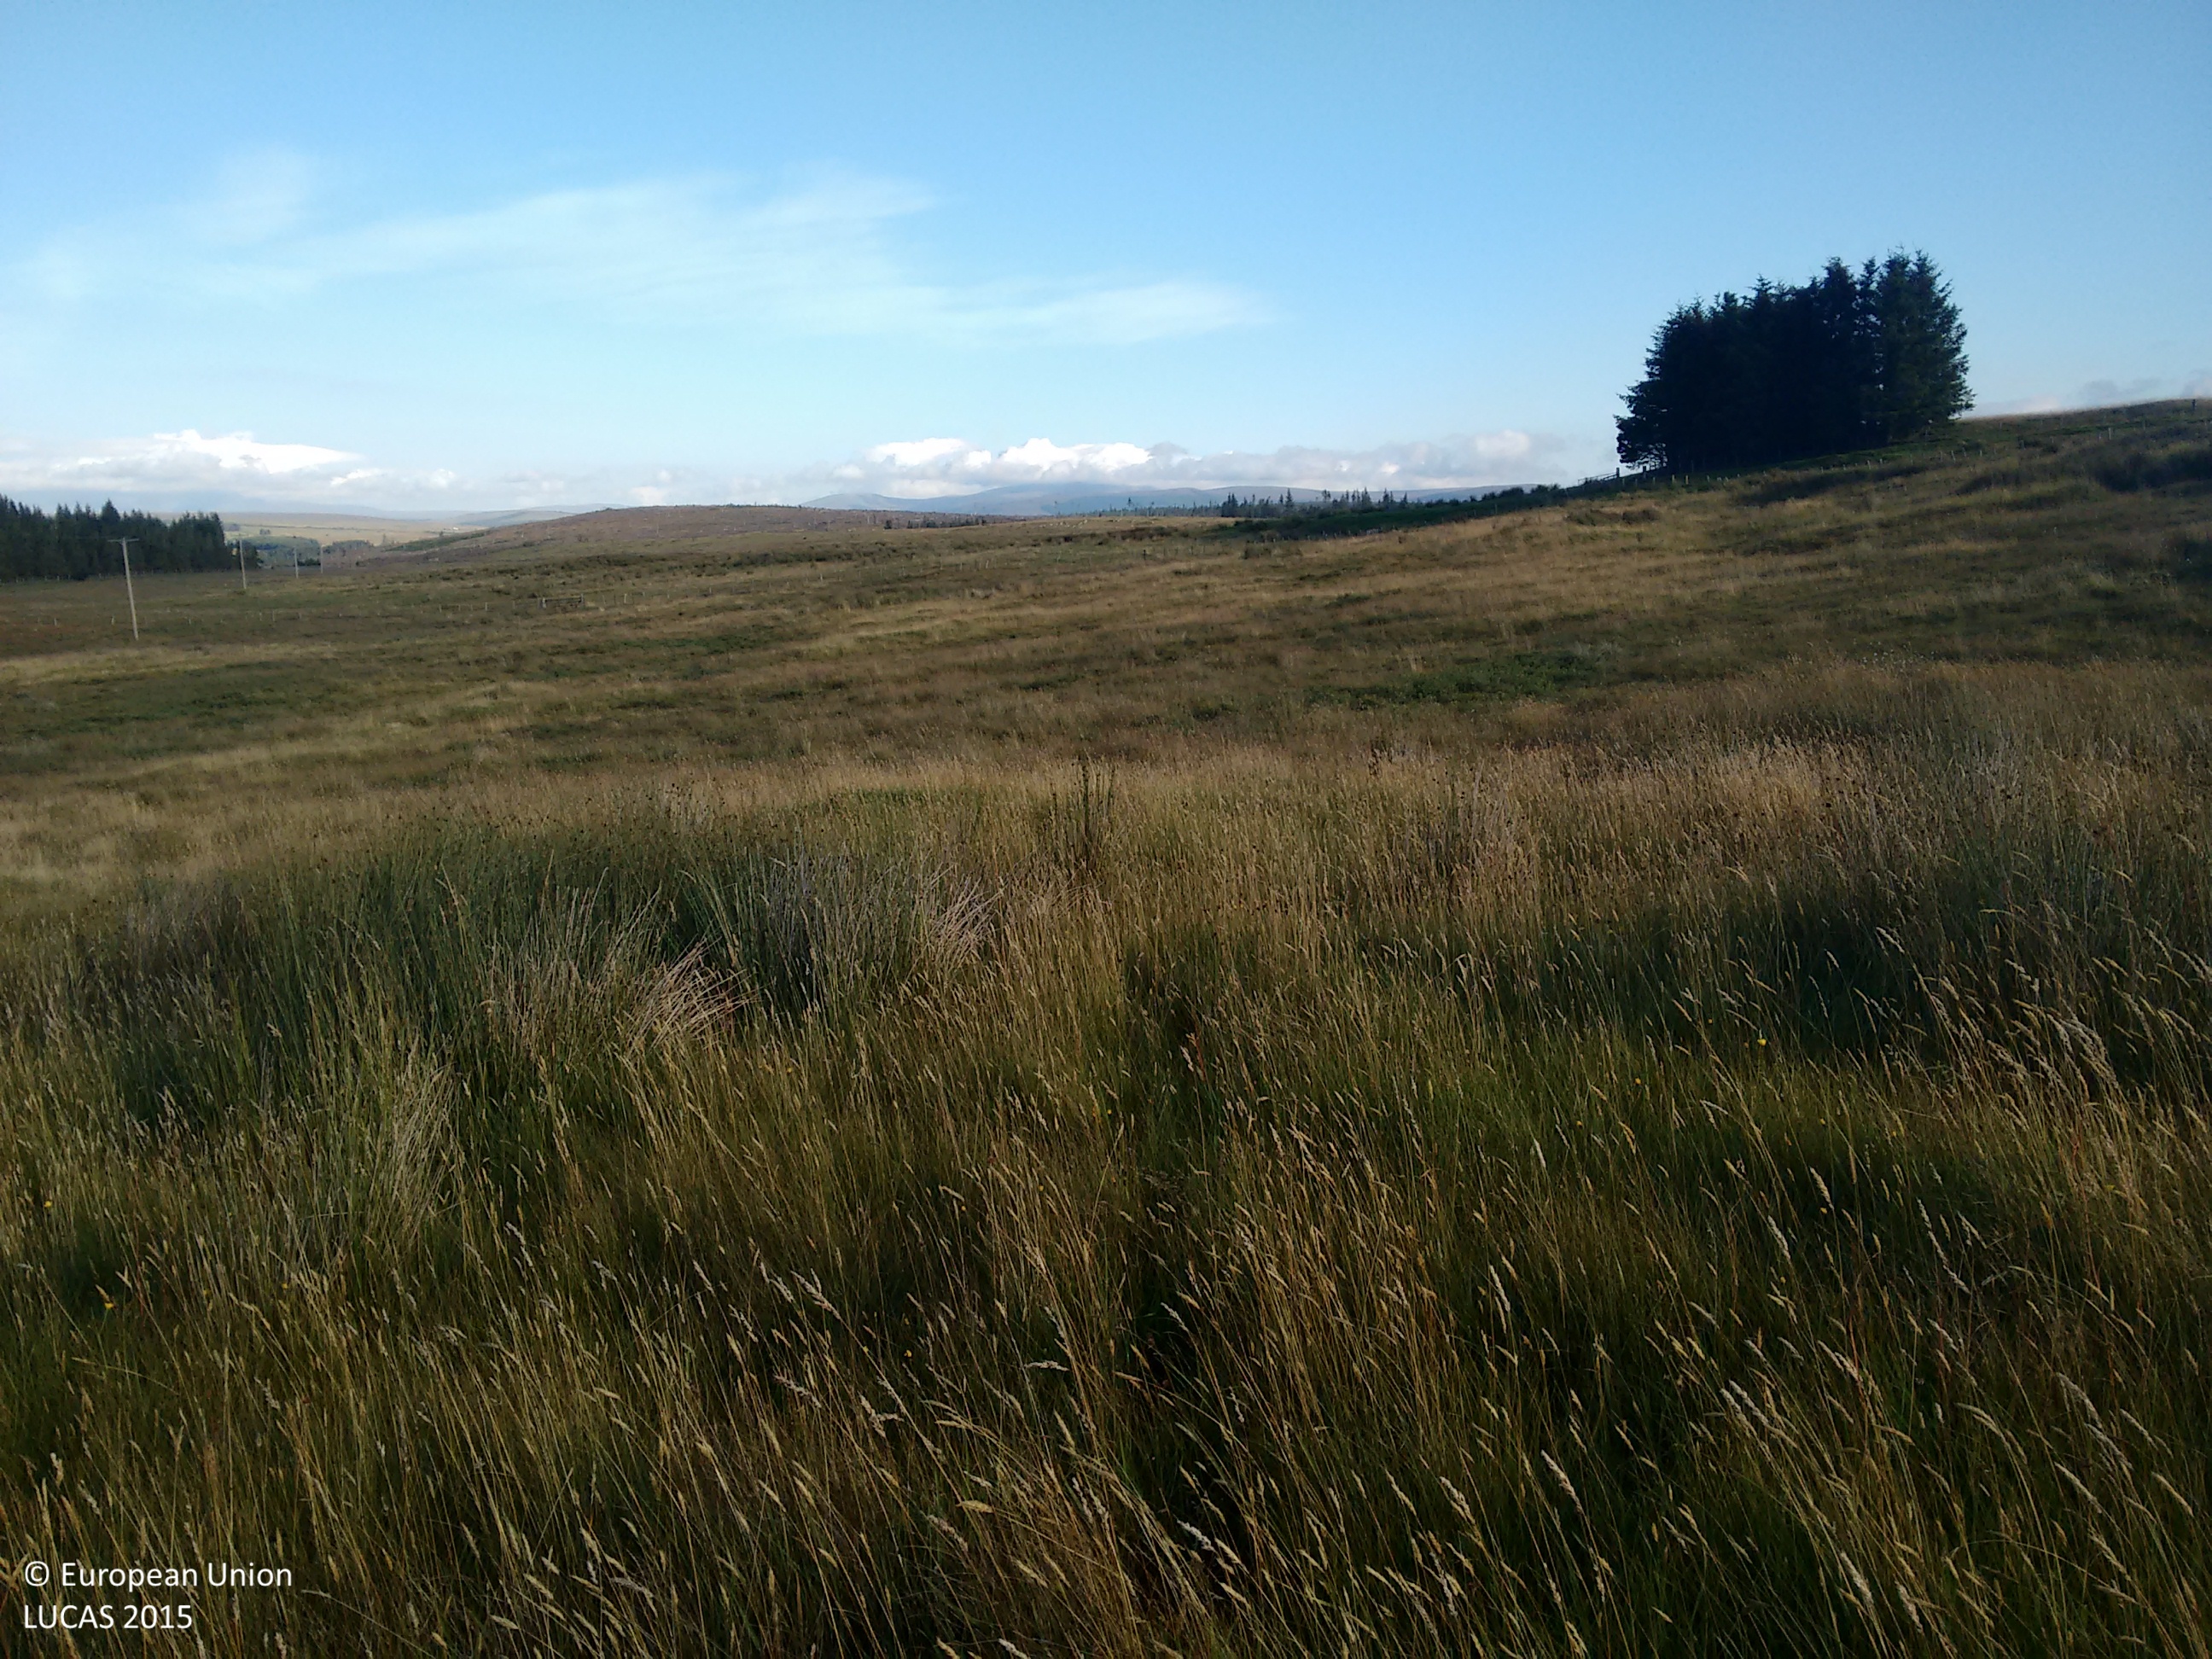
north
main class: Grassland
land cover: Grassland without tree/shrub cover
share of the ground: > 75 %
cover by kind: herbaceous plants 100 %
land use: Agriculture (excluding fallow land and kitchen gardens)
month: September
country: GB
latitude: 58.0428
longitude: -4.3996
